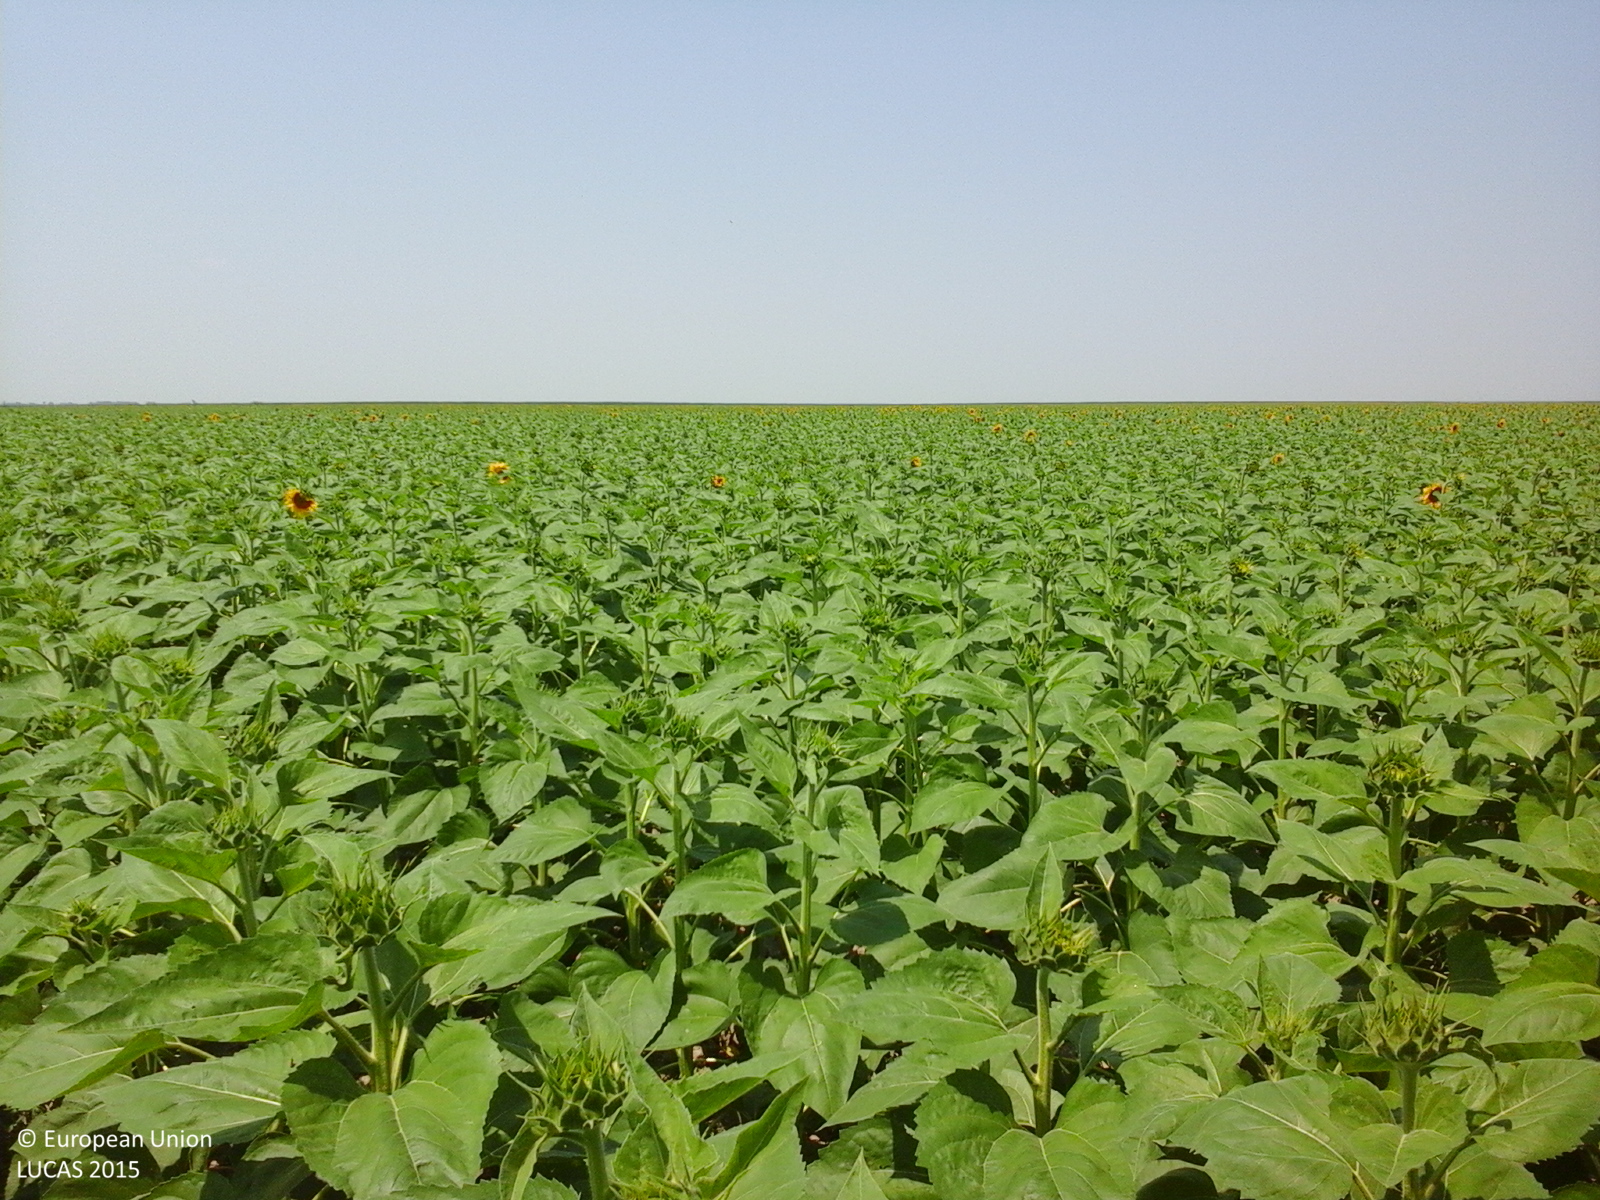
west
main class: Cropland
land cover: Sunflower
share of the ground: > 75 %
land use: Agriculture (excluding fallow land and kitchen gardens)
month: July
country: RO
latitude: 44.7569
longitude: 25.7259
